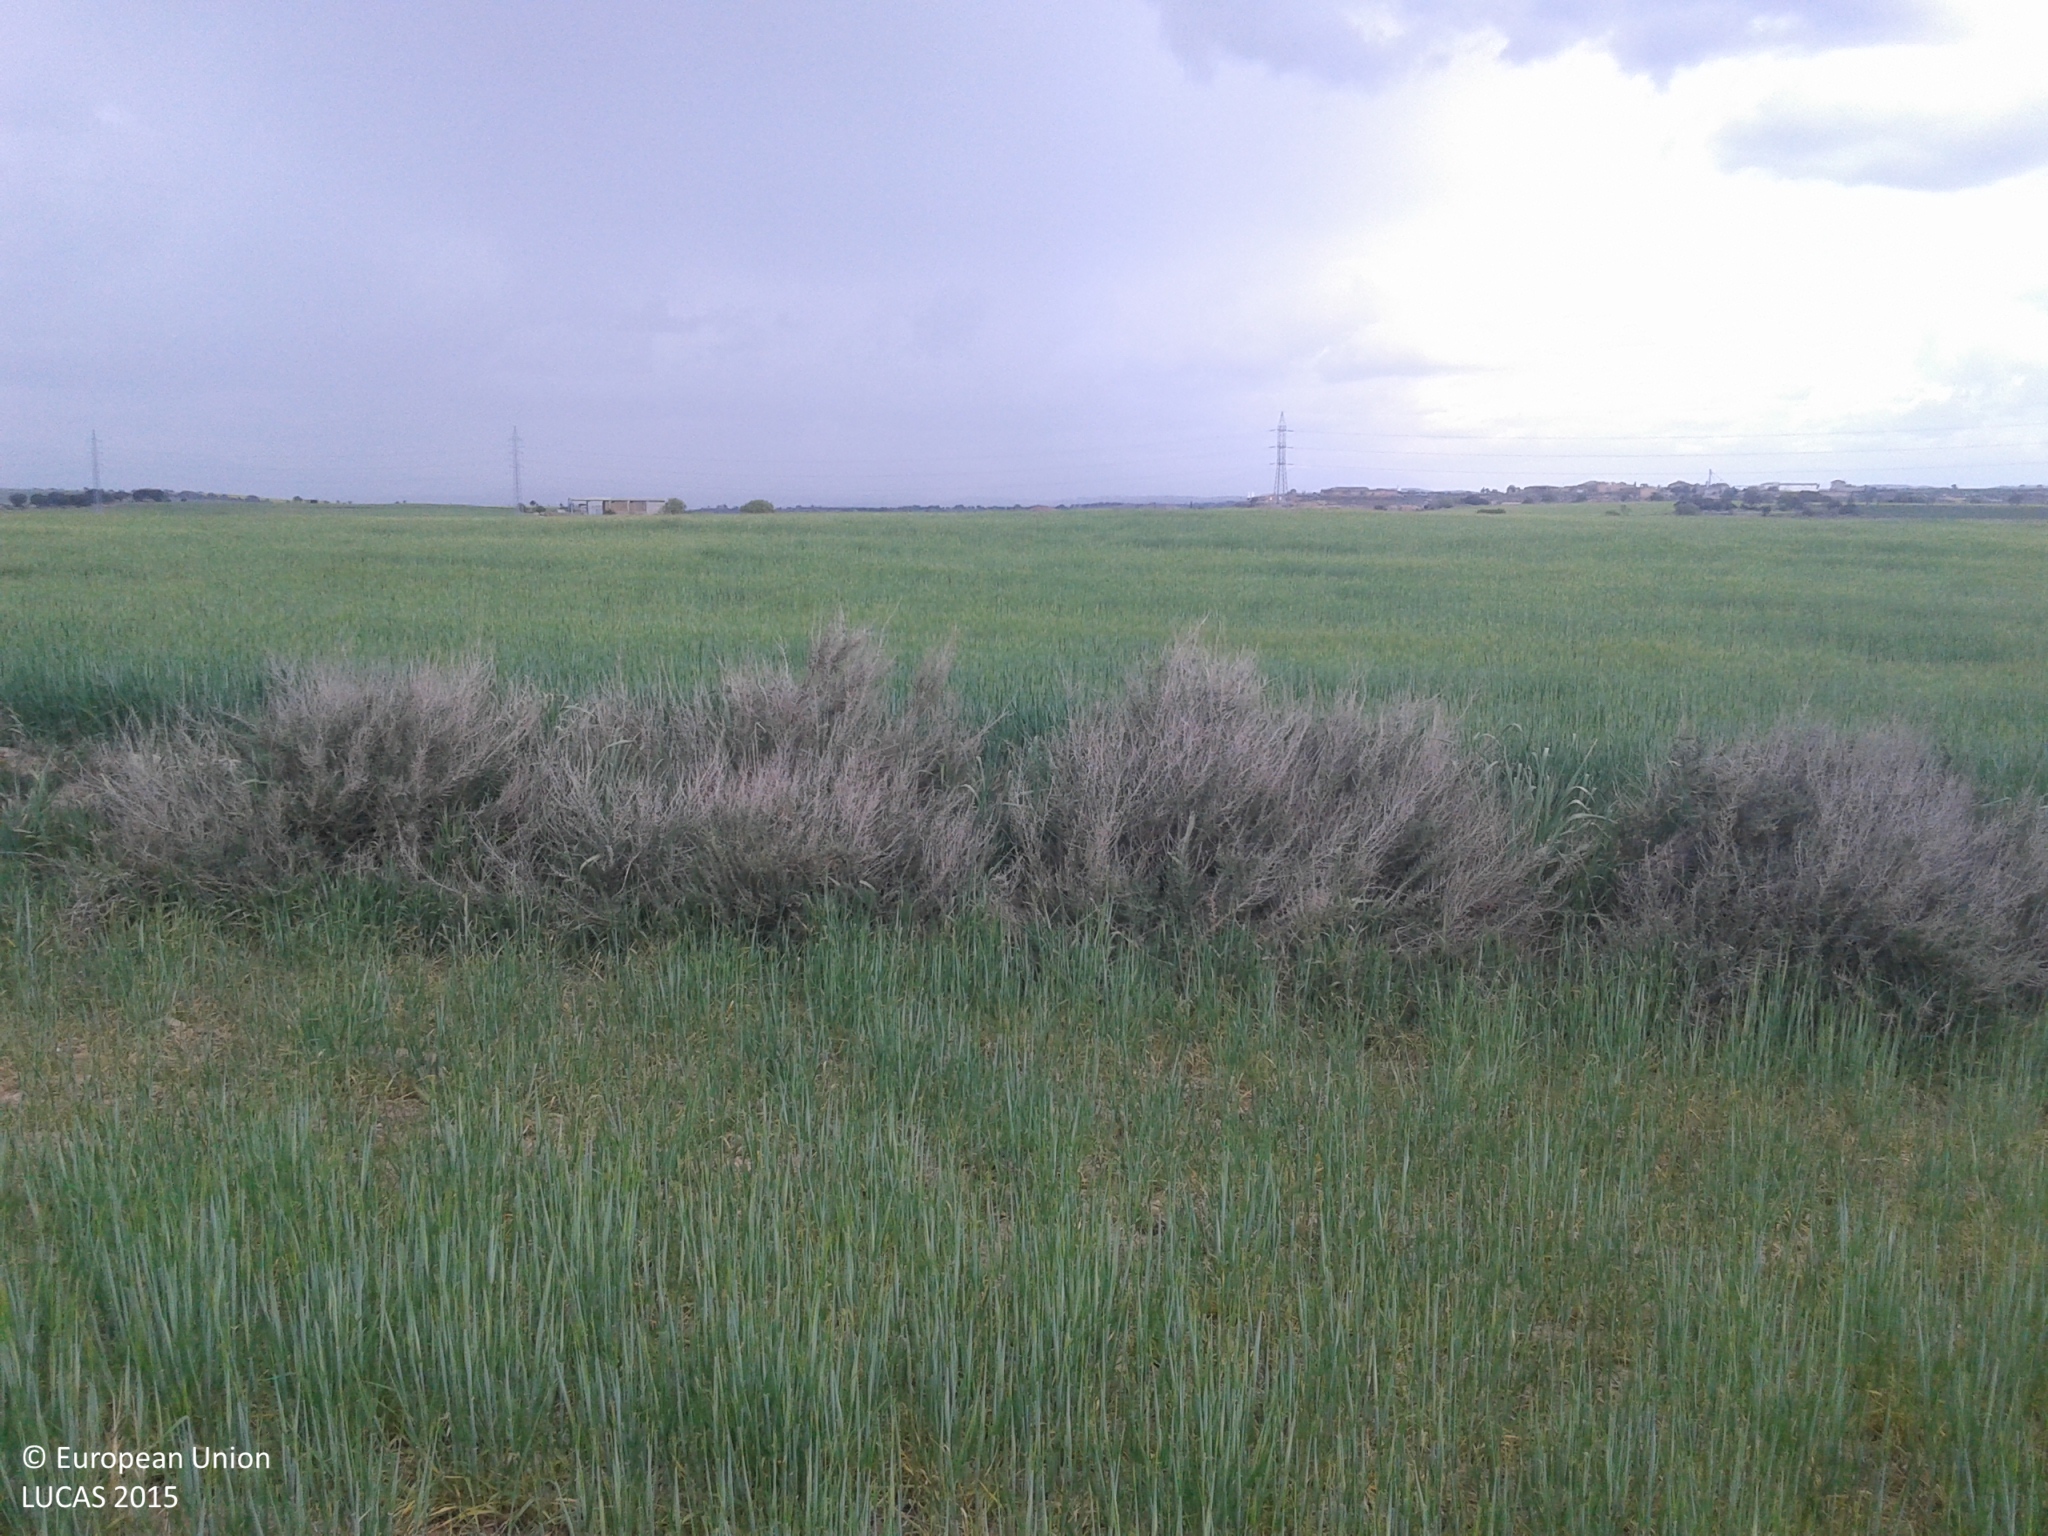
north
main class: Cropland
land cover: Barley
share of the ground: > 75 %
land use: Agriculture (excluding fallow land and kitchen gardens)
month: April
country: ES
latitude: 41.7394
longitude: 1.1514
